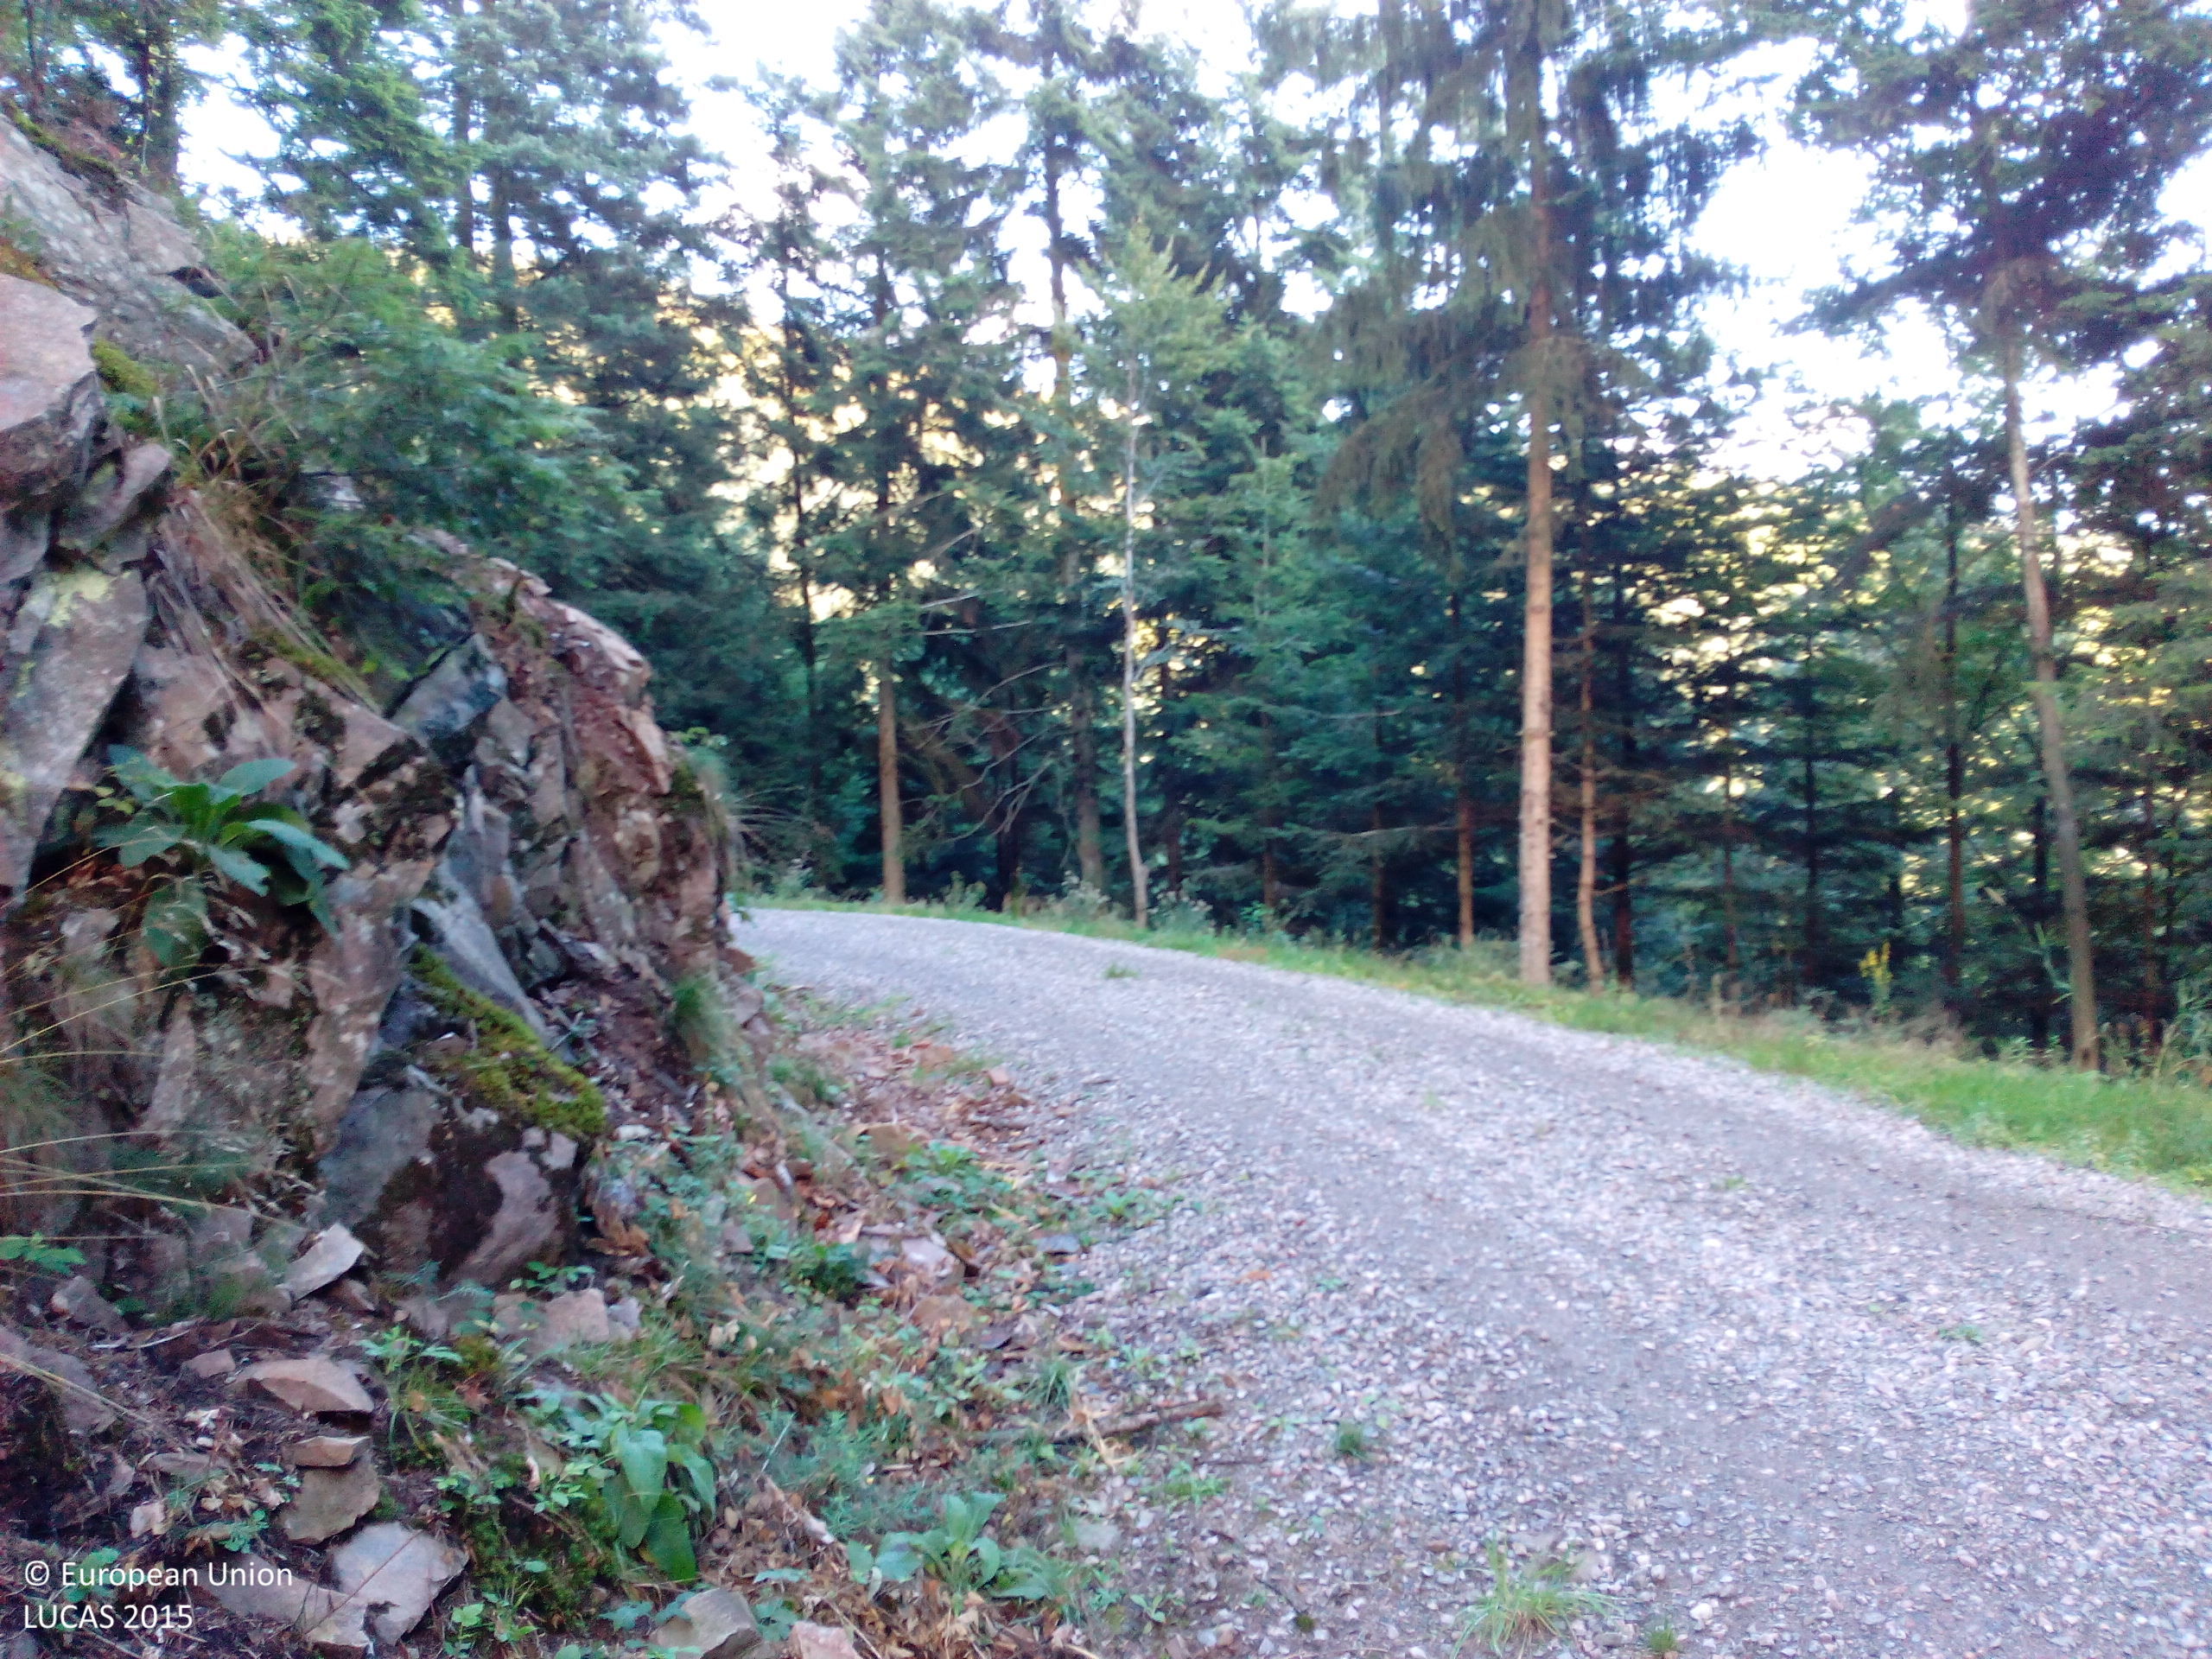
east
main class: Woodland
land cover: Other mixed woodland
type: hemiboreal forest and nemoral coniferous forest and mixed broadleaved-coniferous forest
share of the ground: 50 - 75 %
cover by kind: coniferous forest trees 50 %, broadleaved forest trees 25 %, lichens and mosses 25 %
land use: Forestry
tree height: > 5 m
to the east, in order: Other mixed woodland; Tracks; Spruce dominated coniferous woodland; Spruce dominated mixed woodland; Other mixed woodland; Other coniferous woodland; Other mixed woodland
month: September
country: DE
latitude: 48.2972
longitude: 8.1002
